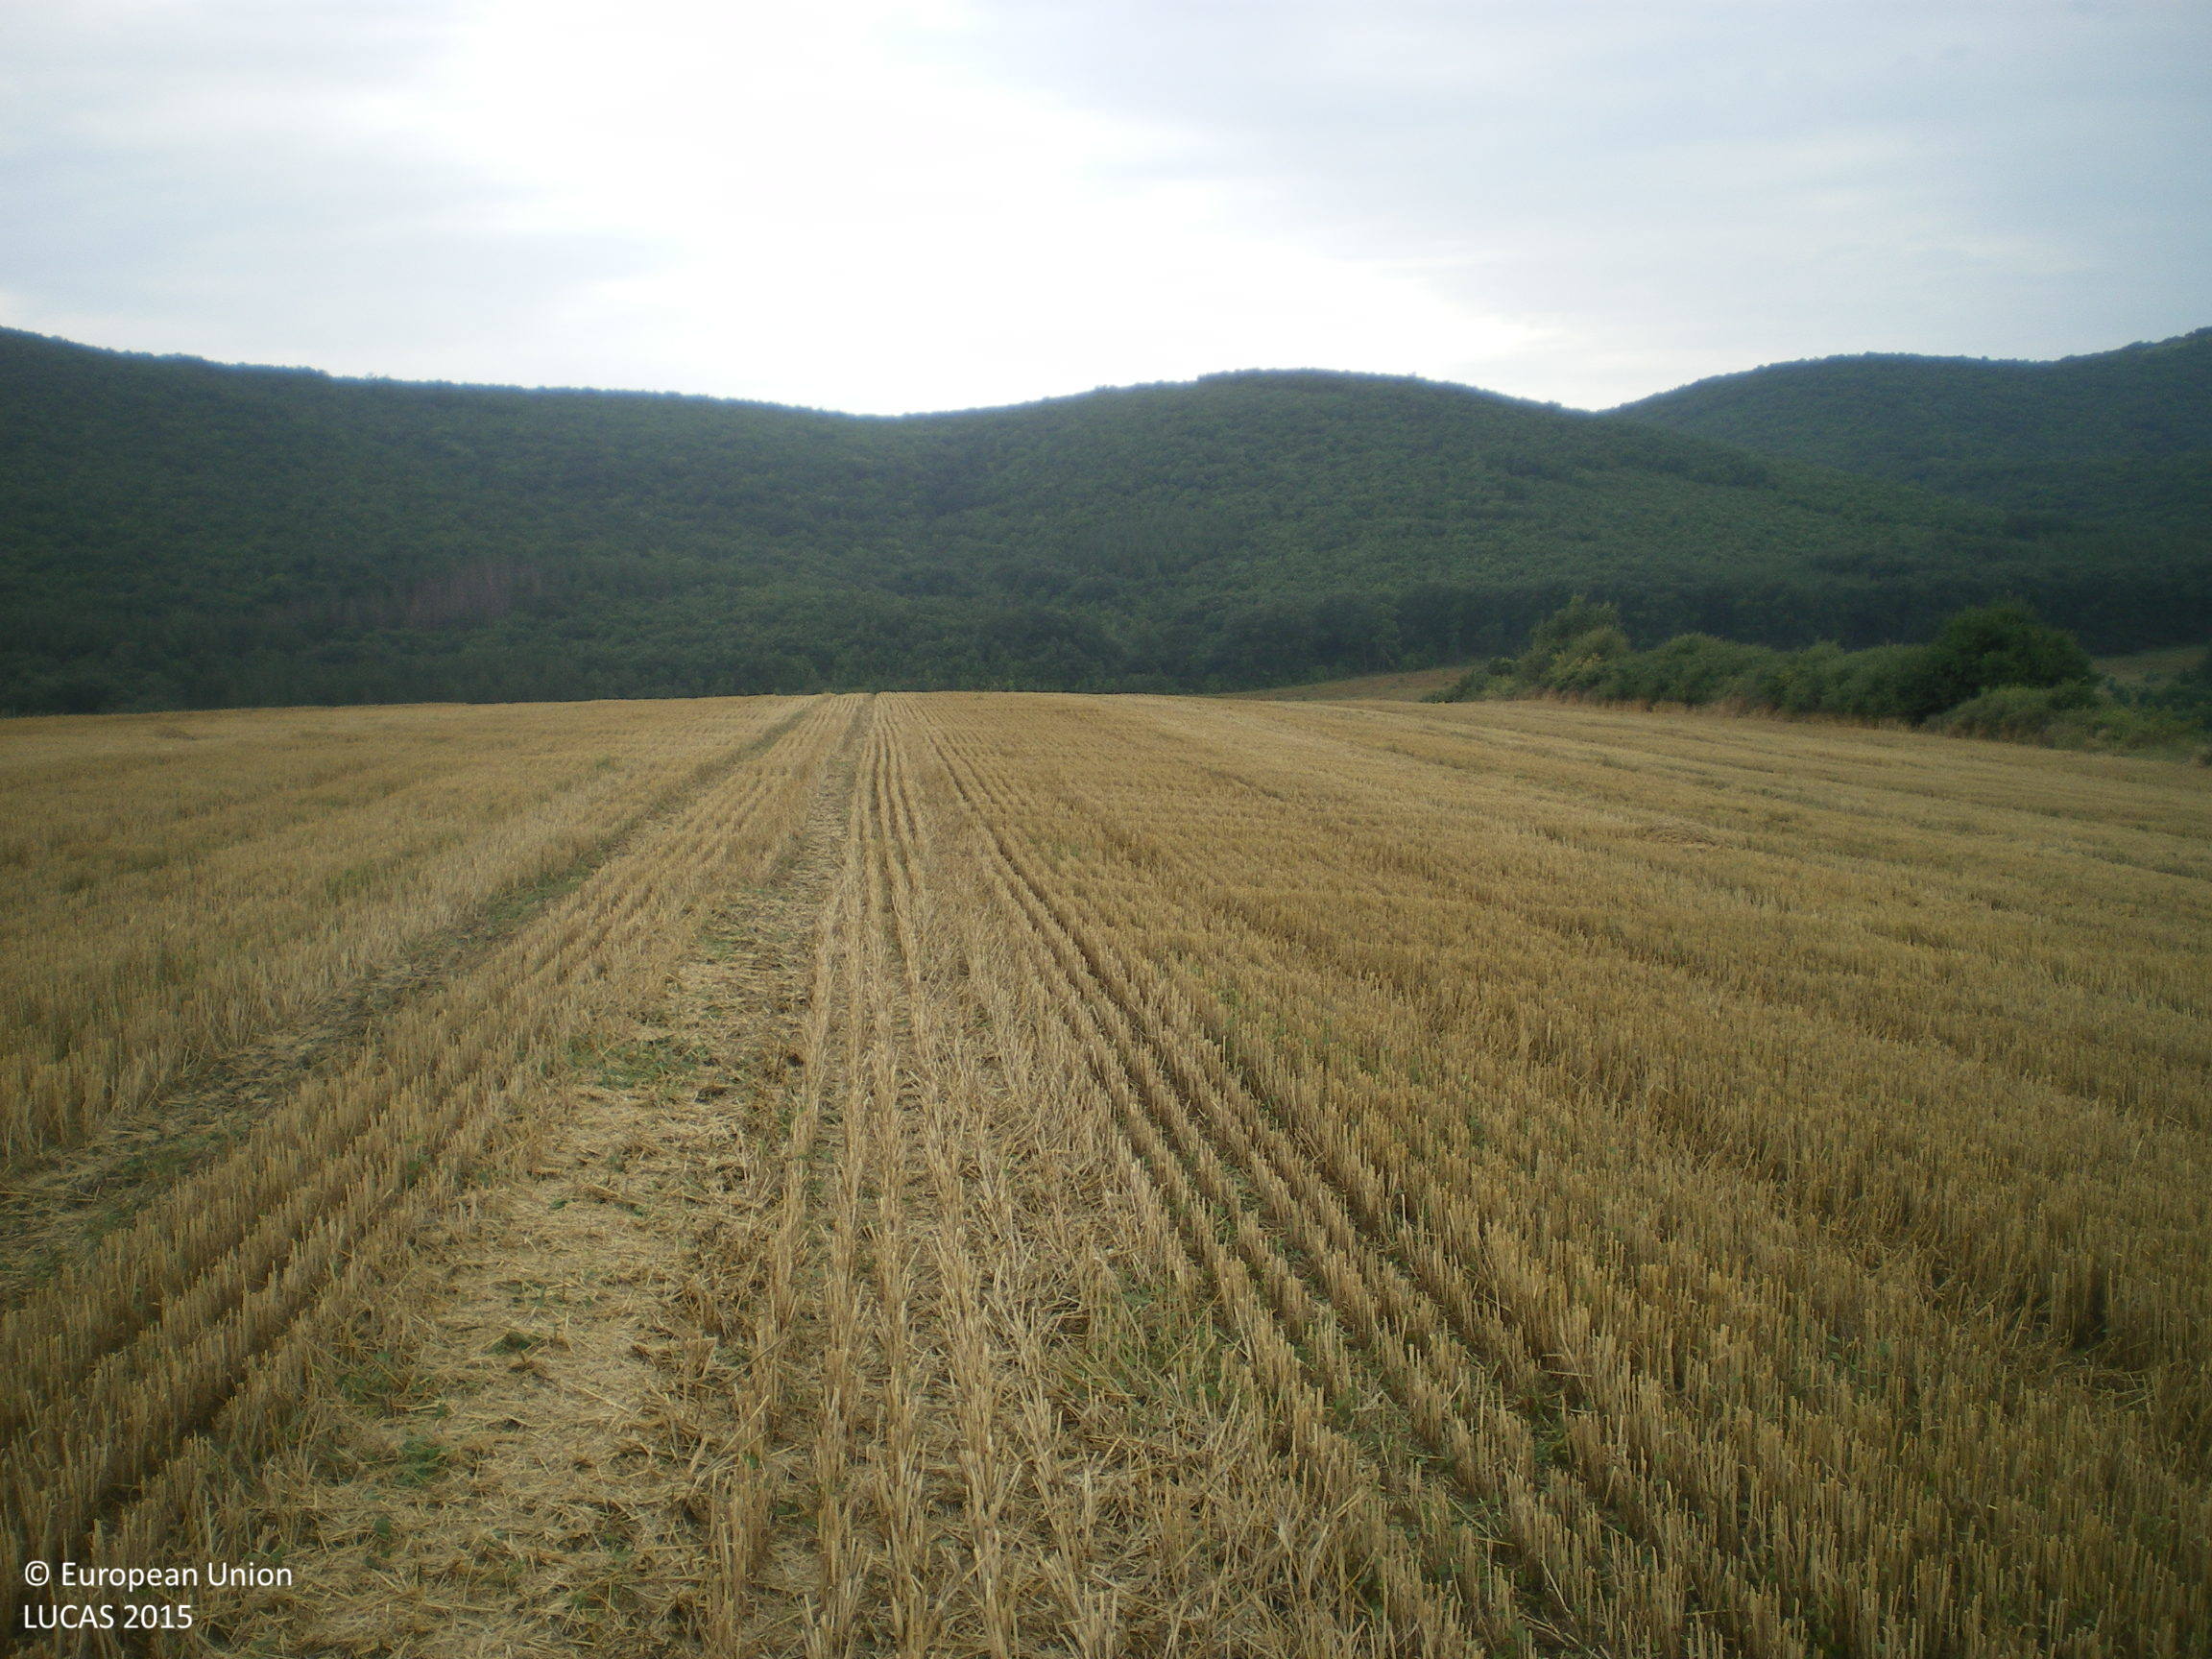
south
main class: Cropland
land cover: Common wheat
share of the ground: < 10 %
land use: Agriculture (excluding fallow land and kitchen gardens)
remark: Harvested field
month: July
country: BG
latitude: 42.4028
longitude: 25.2883
